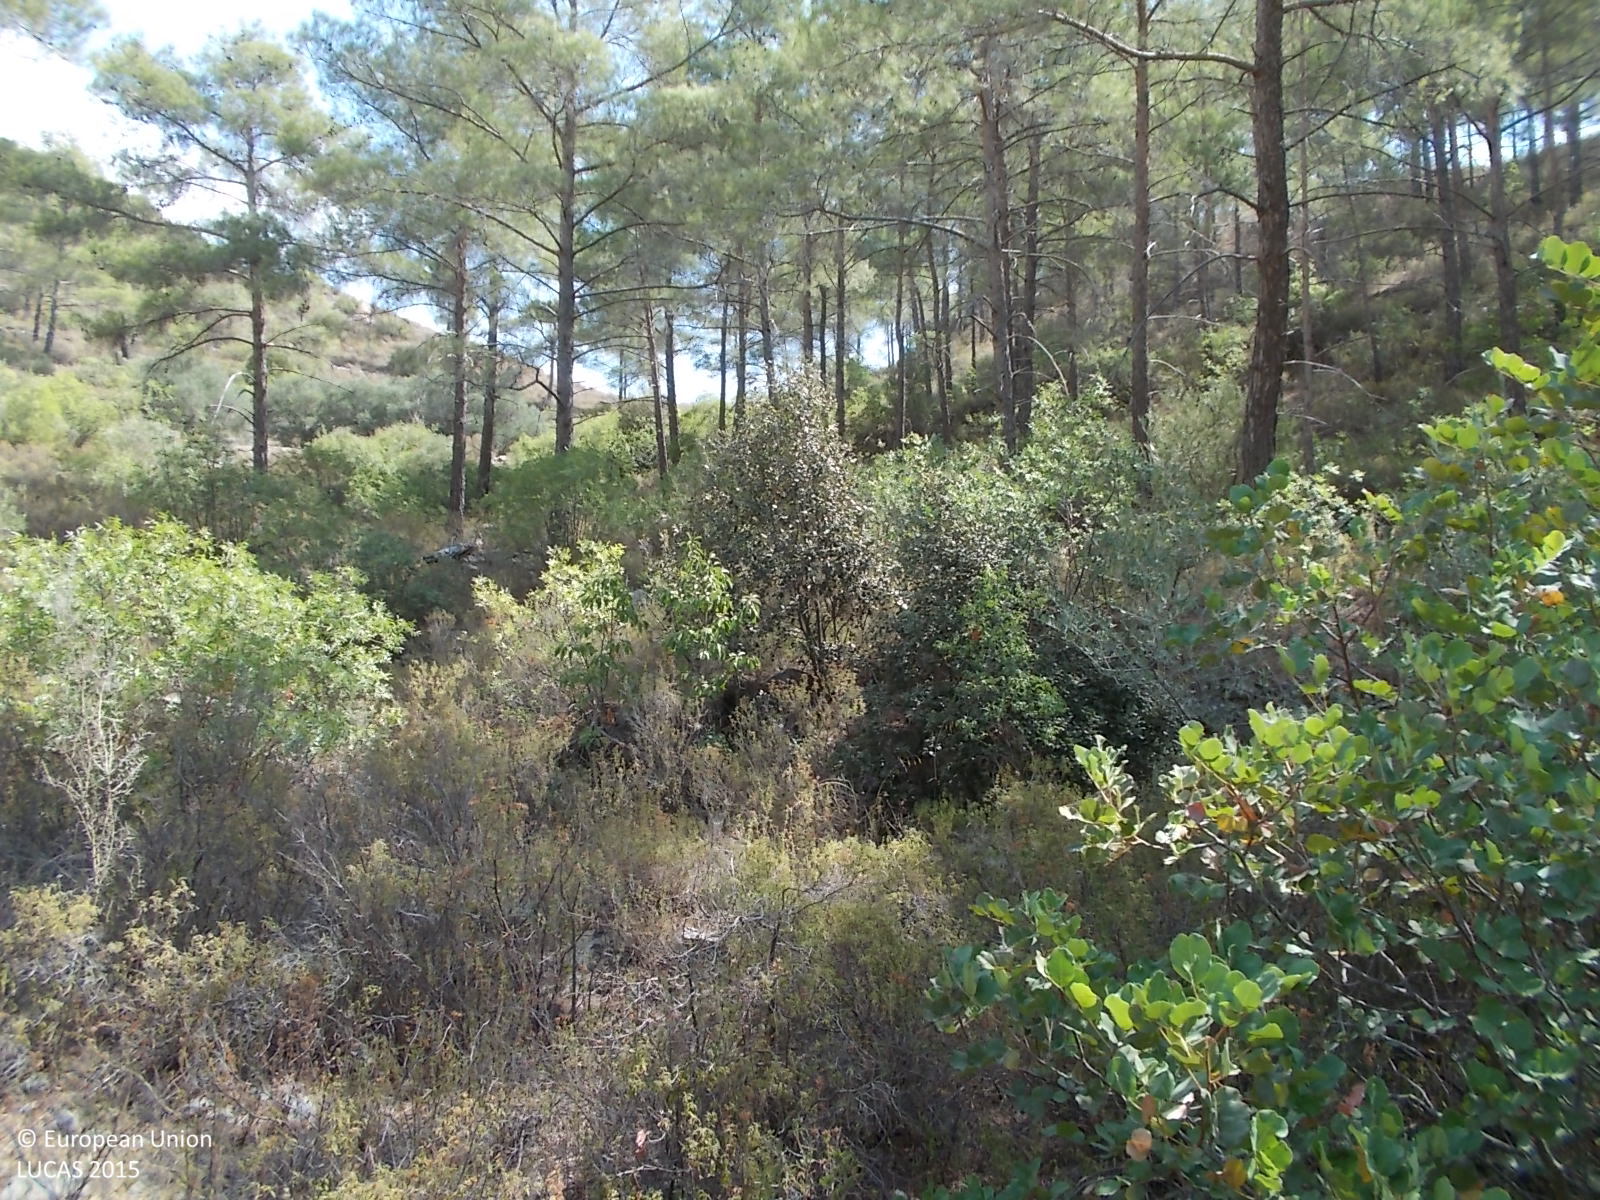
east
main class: Woodland
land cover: Pine dominated mixed woodland
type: coniferous forest of the mediterranean region
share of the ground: 50 - 75 %
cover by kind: coniferous forest trees 45 %, shrubs 25 %, broadleaved forest trees 15 %, unconsolidated bare surface 15 %
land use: Semi-natural and natural areas not in use
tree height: > 5 m
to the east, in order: Pine dominated mixed woodland; Dry stone walls; Pine dominated mixed woodland; Dry stone walls; Shrubland without tree cover; Dry stone walls; Olive groves; Shrubland with sparse tree cover; Pine dominated coniferous woodland; Shrubland with sparse tree cover; Shrubland without tree cover
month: September
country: CY
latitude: 34.8648
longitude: 33.0896
